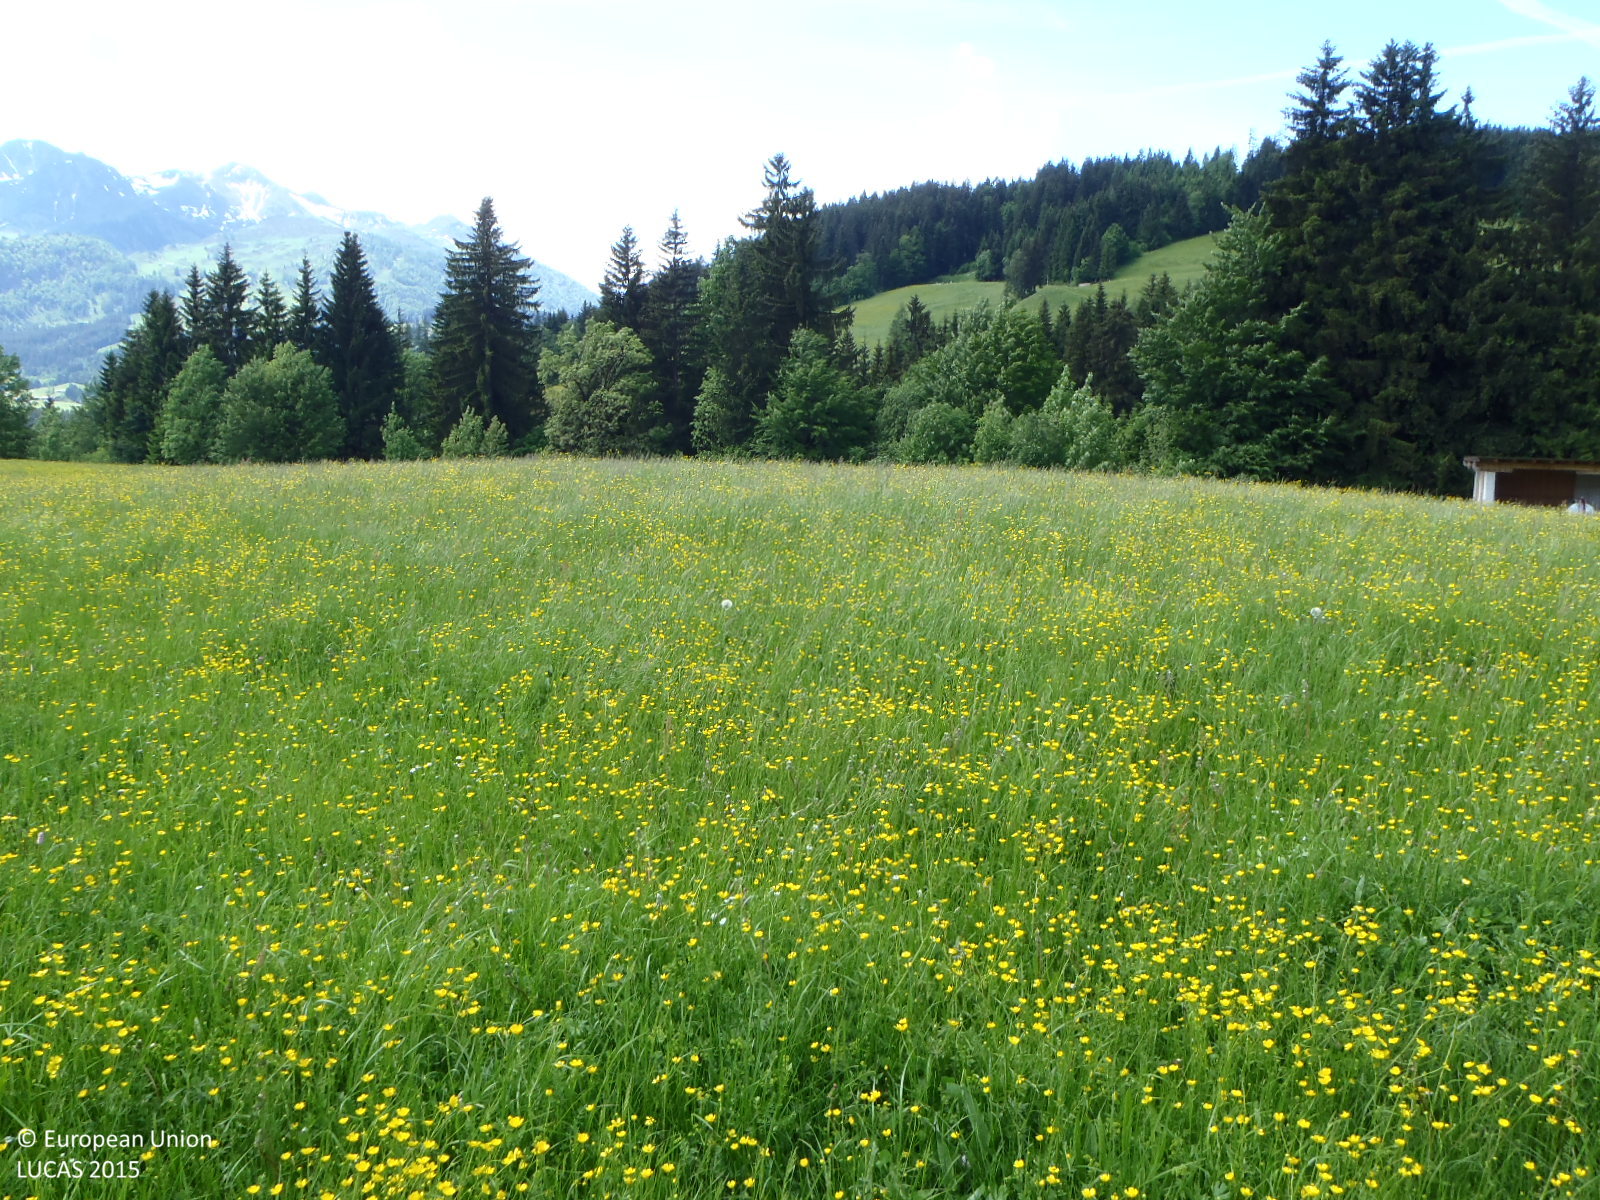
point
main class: Grassland
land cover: Grassland without tree/shrub cover
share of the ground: > 75 %
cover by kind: herbaceous plants 100 %
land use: Agriculture (excluding fallow land and kitchen gardens)
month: June
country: AT
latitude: 47.4723
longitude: 12.6121
